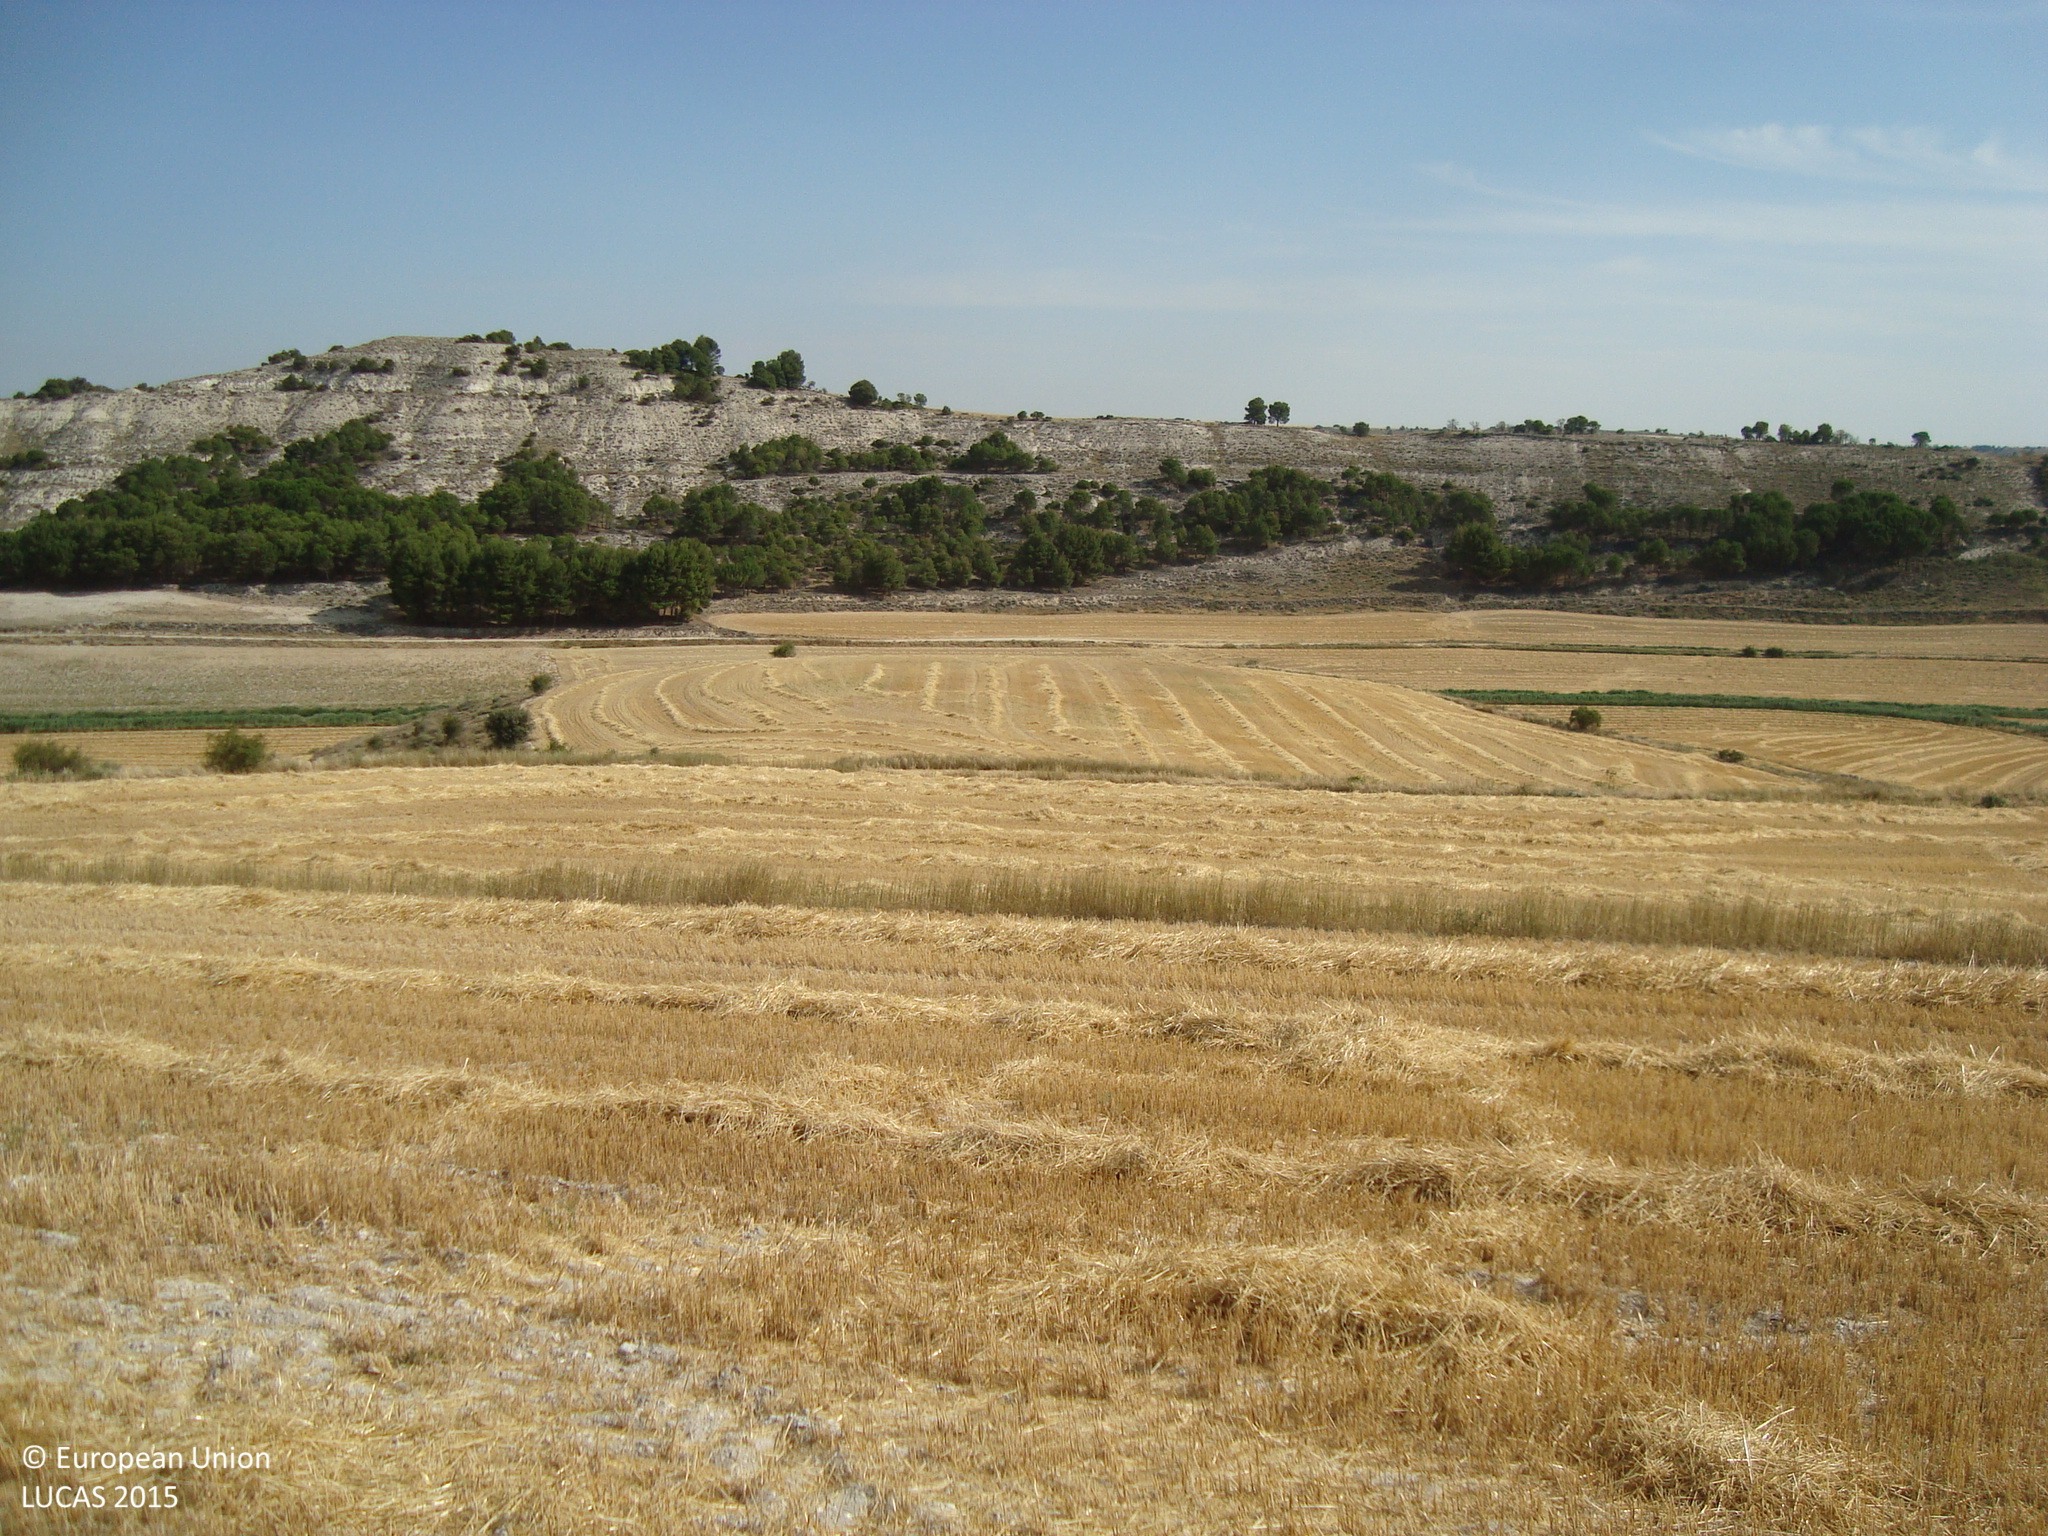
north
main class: Cropland
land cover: Barley
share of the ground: > 75 %
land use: Agriculture (excluding fallow land and kitchen gardens)
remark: Harvested field
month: July
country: ES
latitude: 41.9213
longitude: -4.2077
